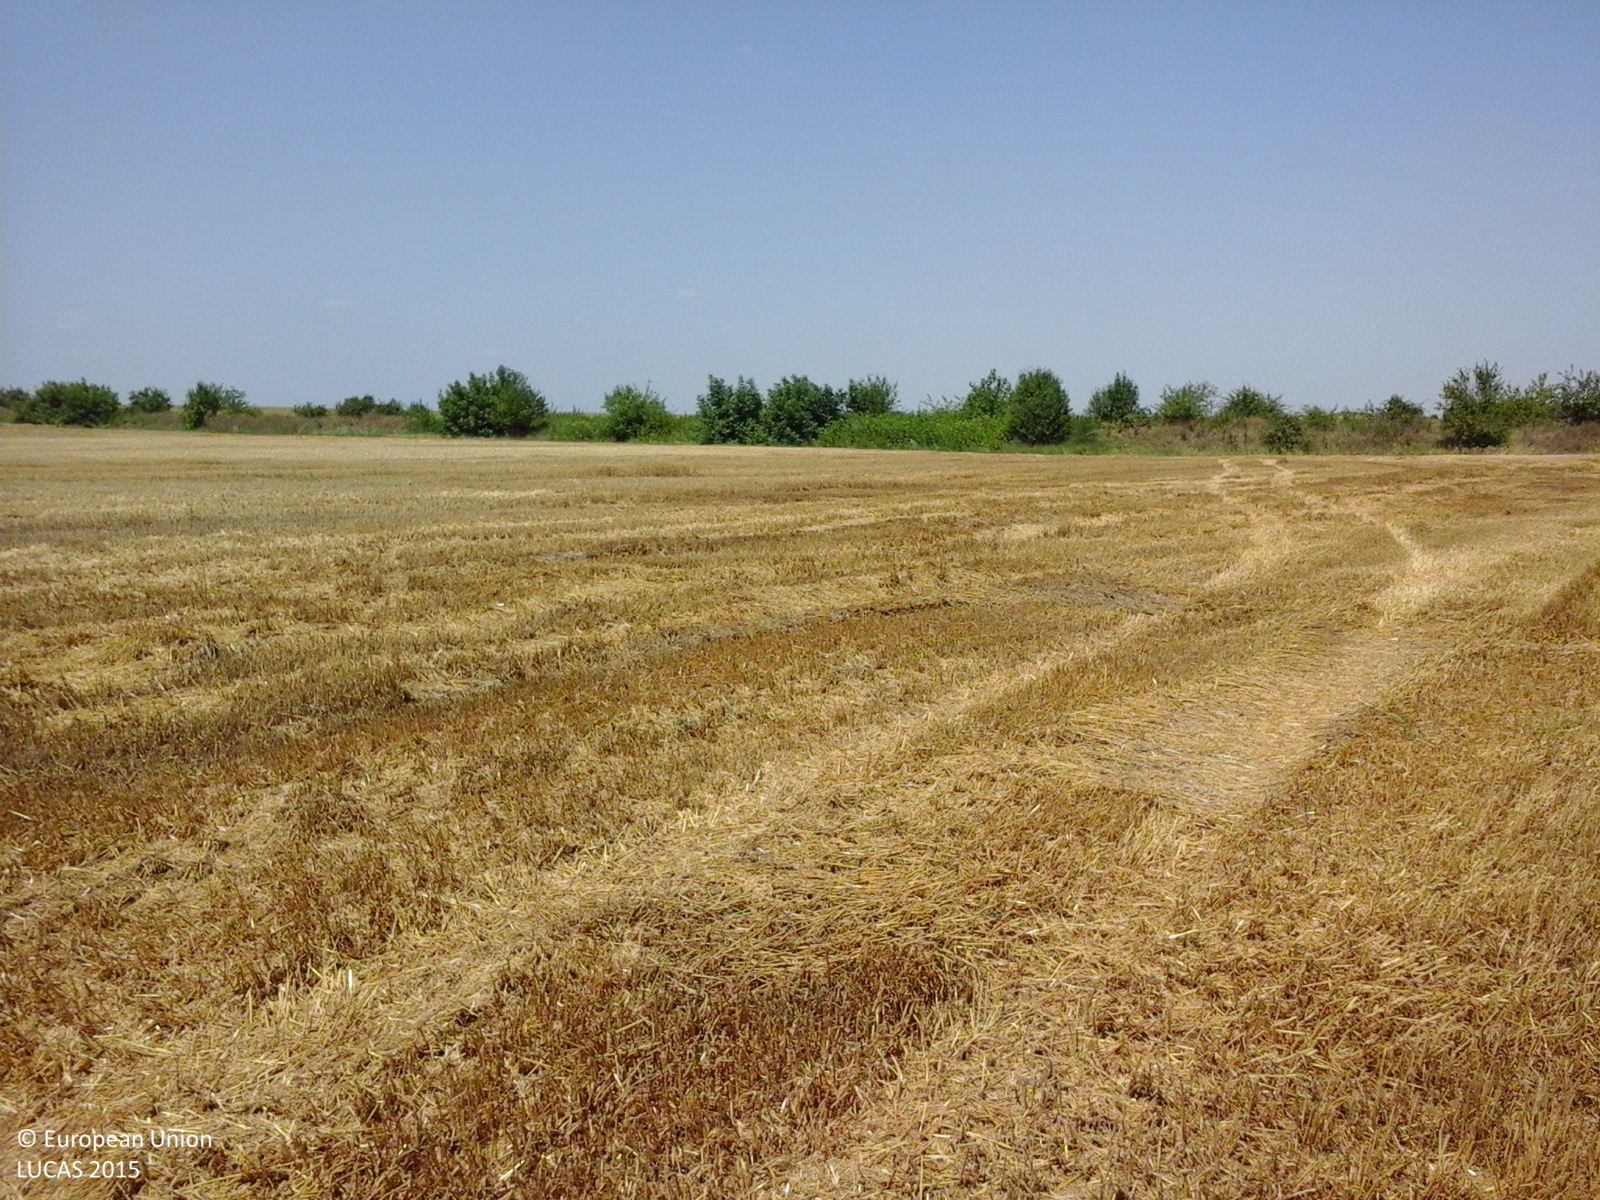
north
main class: Cropland
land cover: Common wheat
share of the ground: > 75 %
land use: Agriculture (excluding fallow land and kitchen gardens)
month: July
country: RO
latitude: 44.2510
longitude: 26.9441
